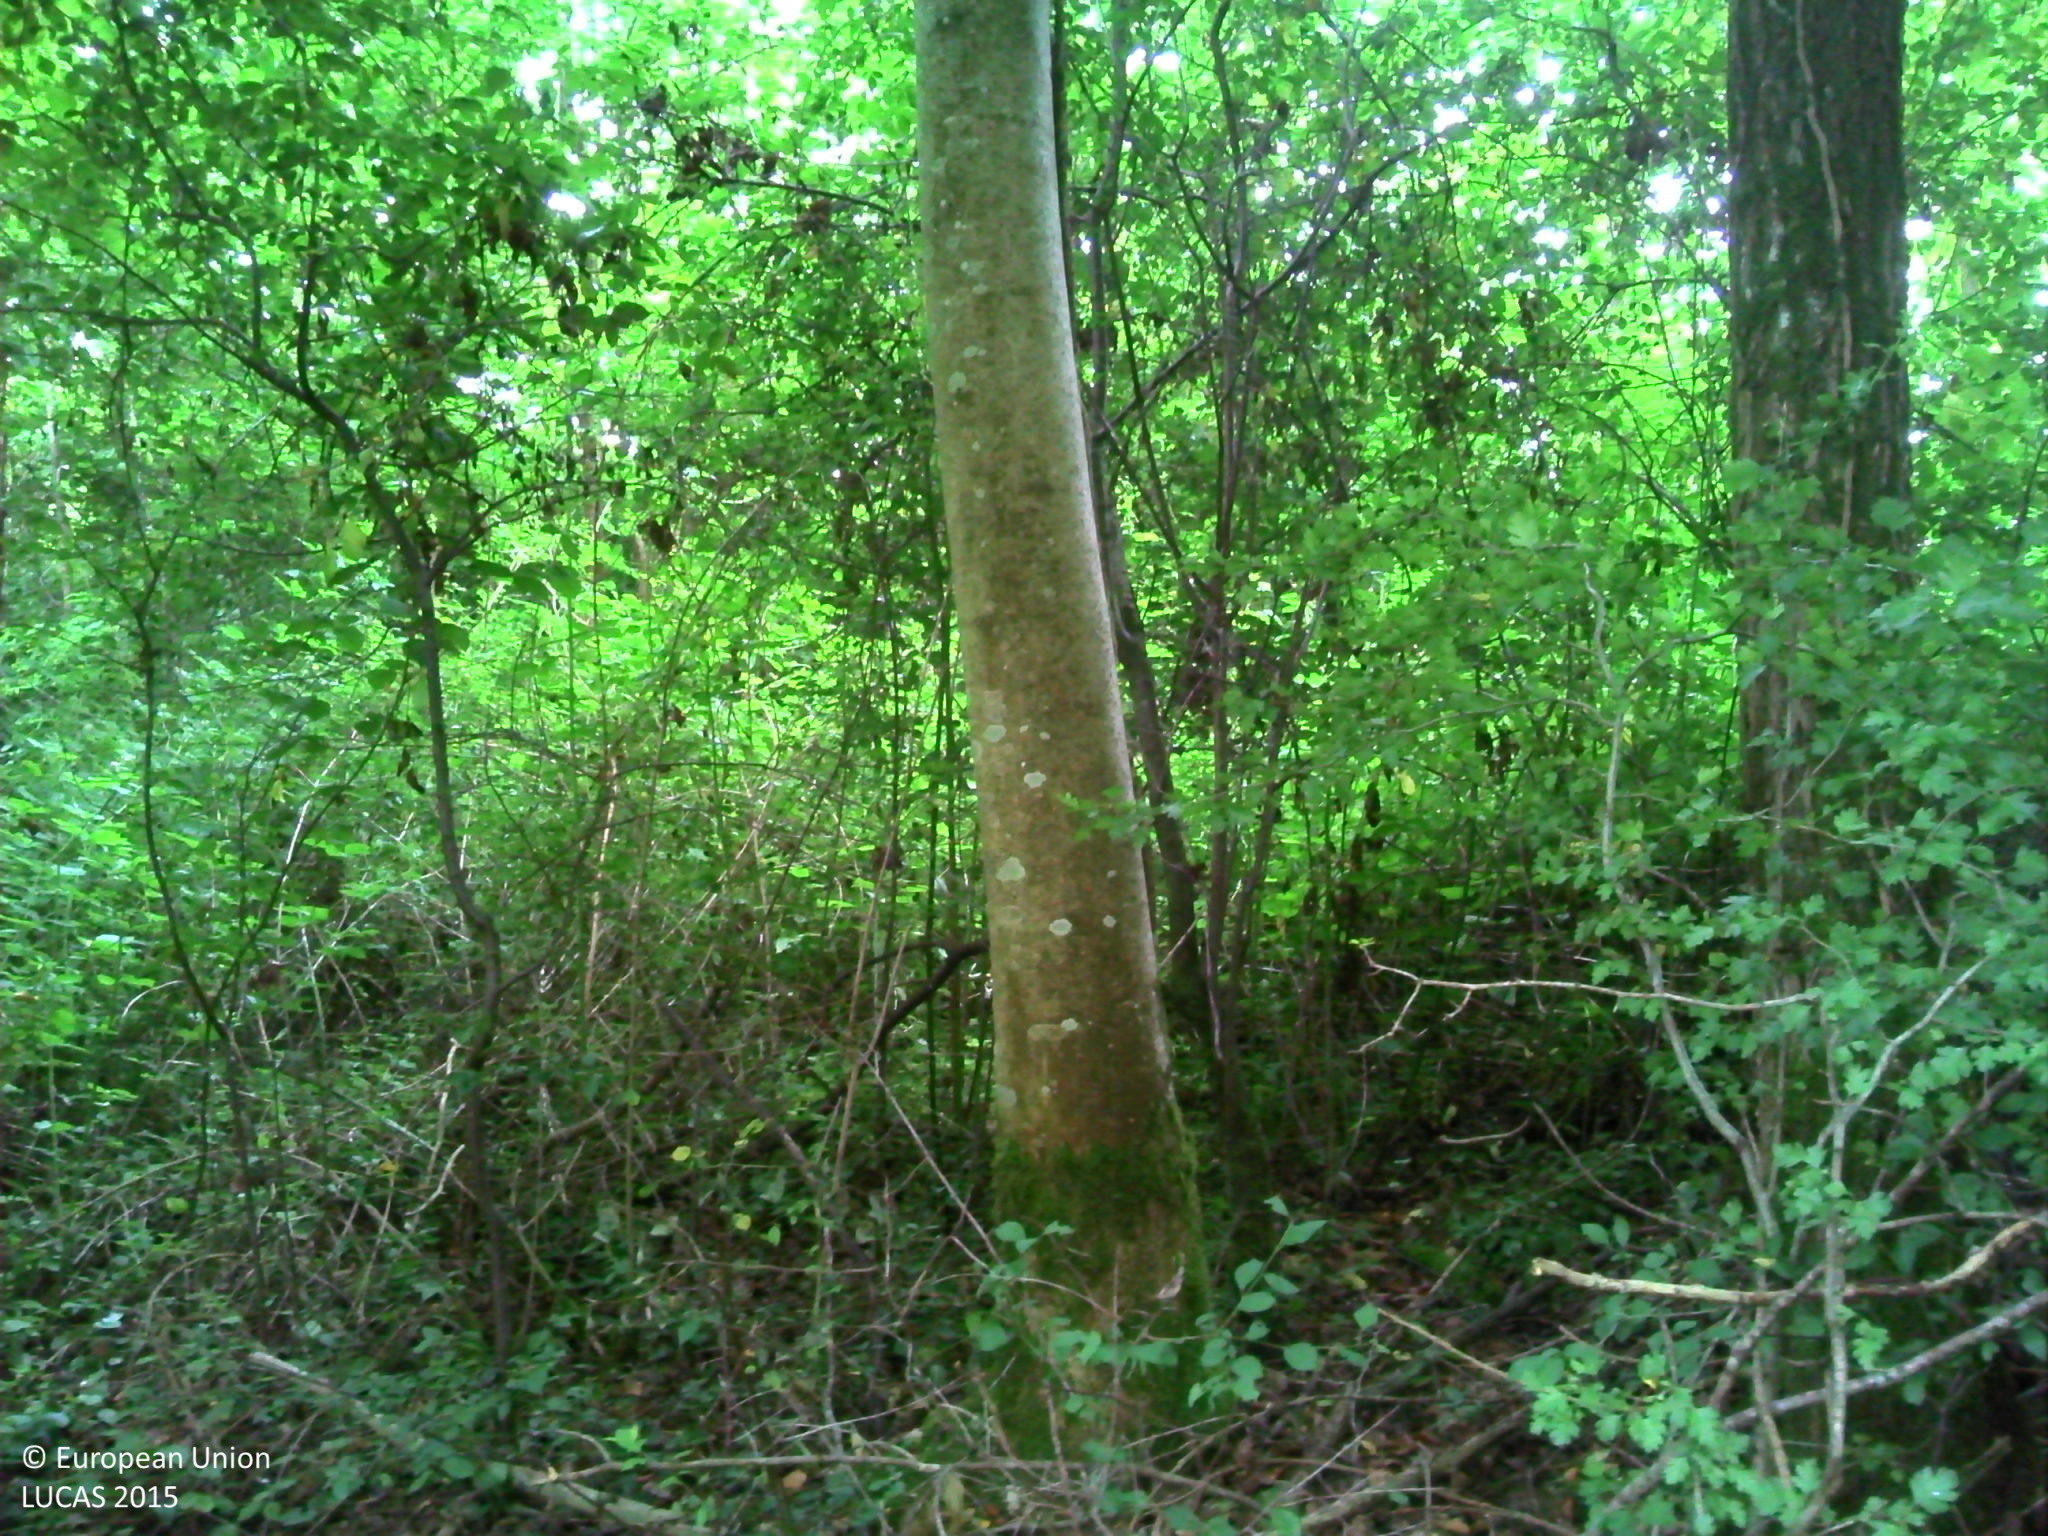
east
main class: Woodland
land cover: Broadleaved woodland
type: mesophytic deciduous forest
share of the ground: > 75 %
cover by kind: broadleaved forest trees 85 %, shrubs 10 %, herbaceous plants 5 %
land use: Forestry
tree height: > 5 m
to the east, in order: Broadleaved woodland; Rape and turnip rape; Broadleaved woodland; Grass margins; Tracks; Grass margins; Common wheat; Grass margins; Broadleaved woodland
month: June
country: FR
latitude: 46.7565
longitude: 5.3806
